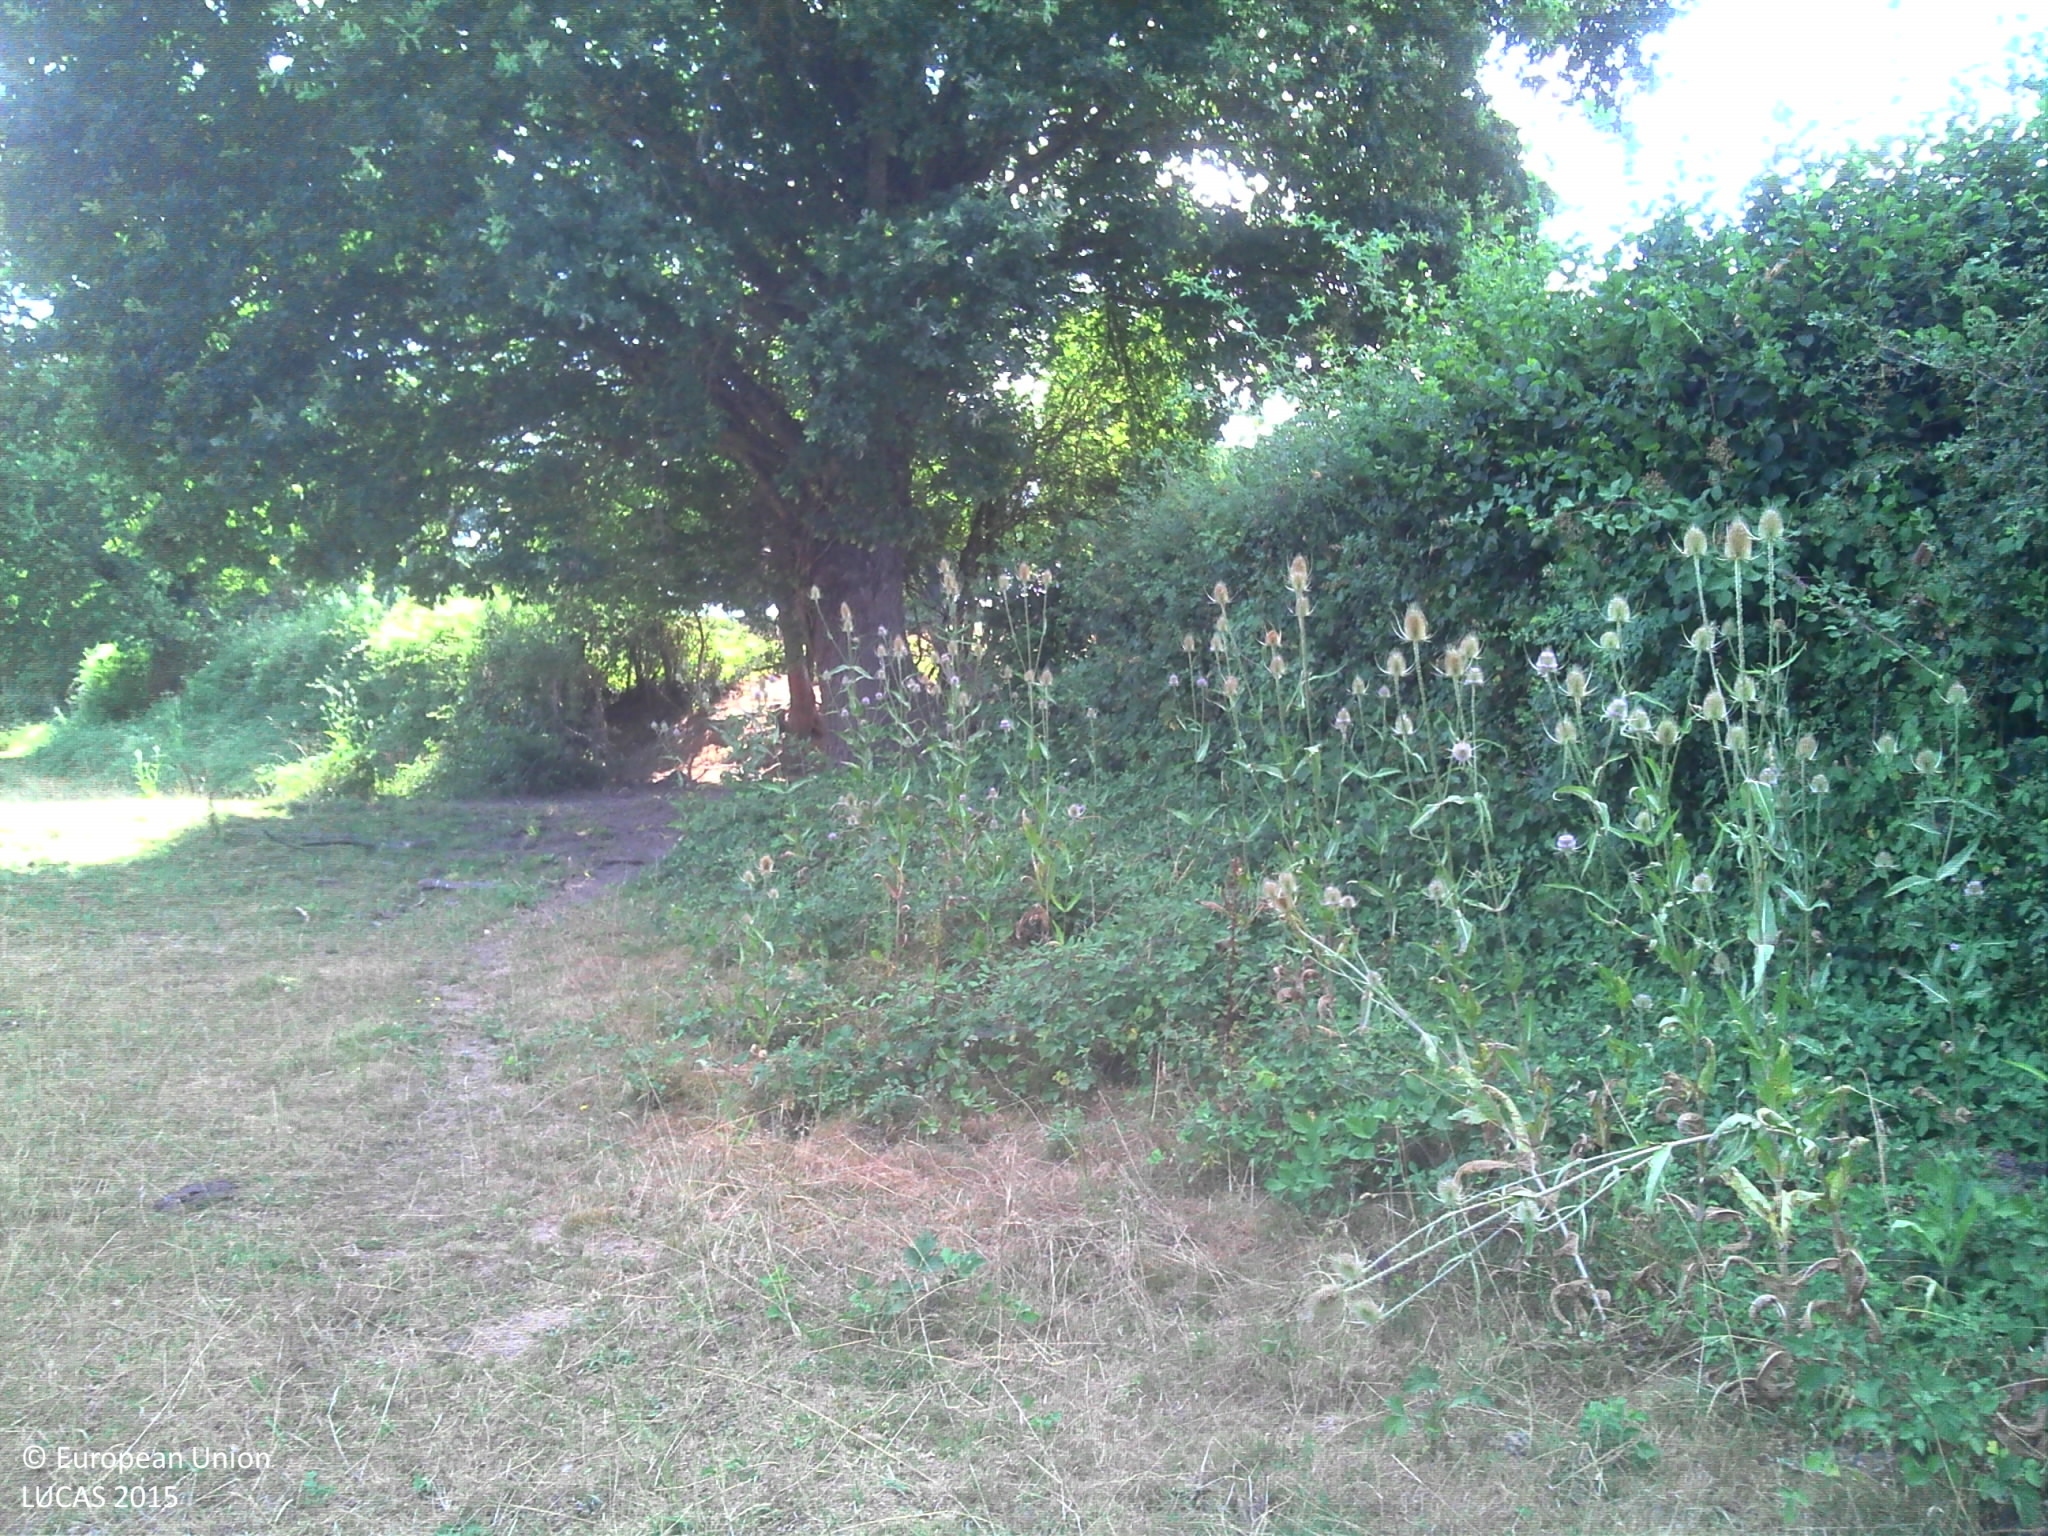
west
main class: Grassland
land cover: Grassland without tree/shrub cover
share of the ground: > 75 %
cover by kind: herbaceous plants 95 %, shrubs 5 %
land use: Agriculture (excluding fallow land and kitchen gardens)
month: July
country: FR
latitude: 46.4817
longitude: 2.9761
